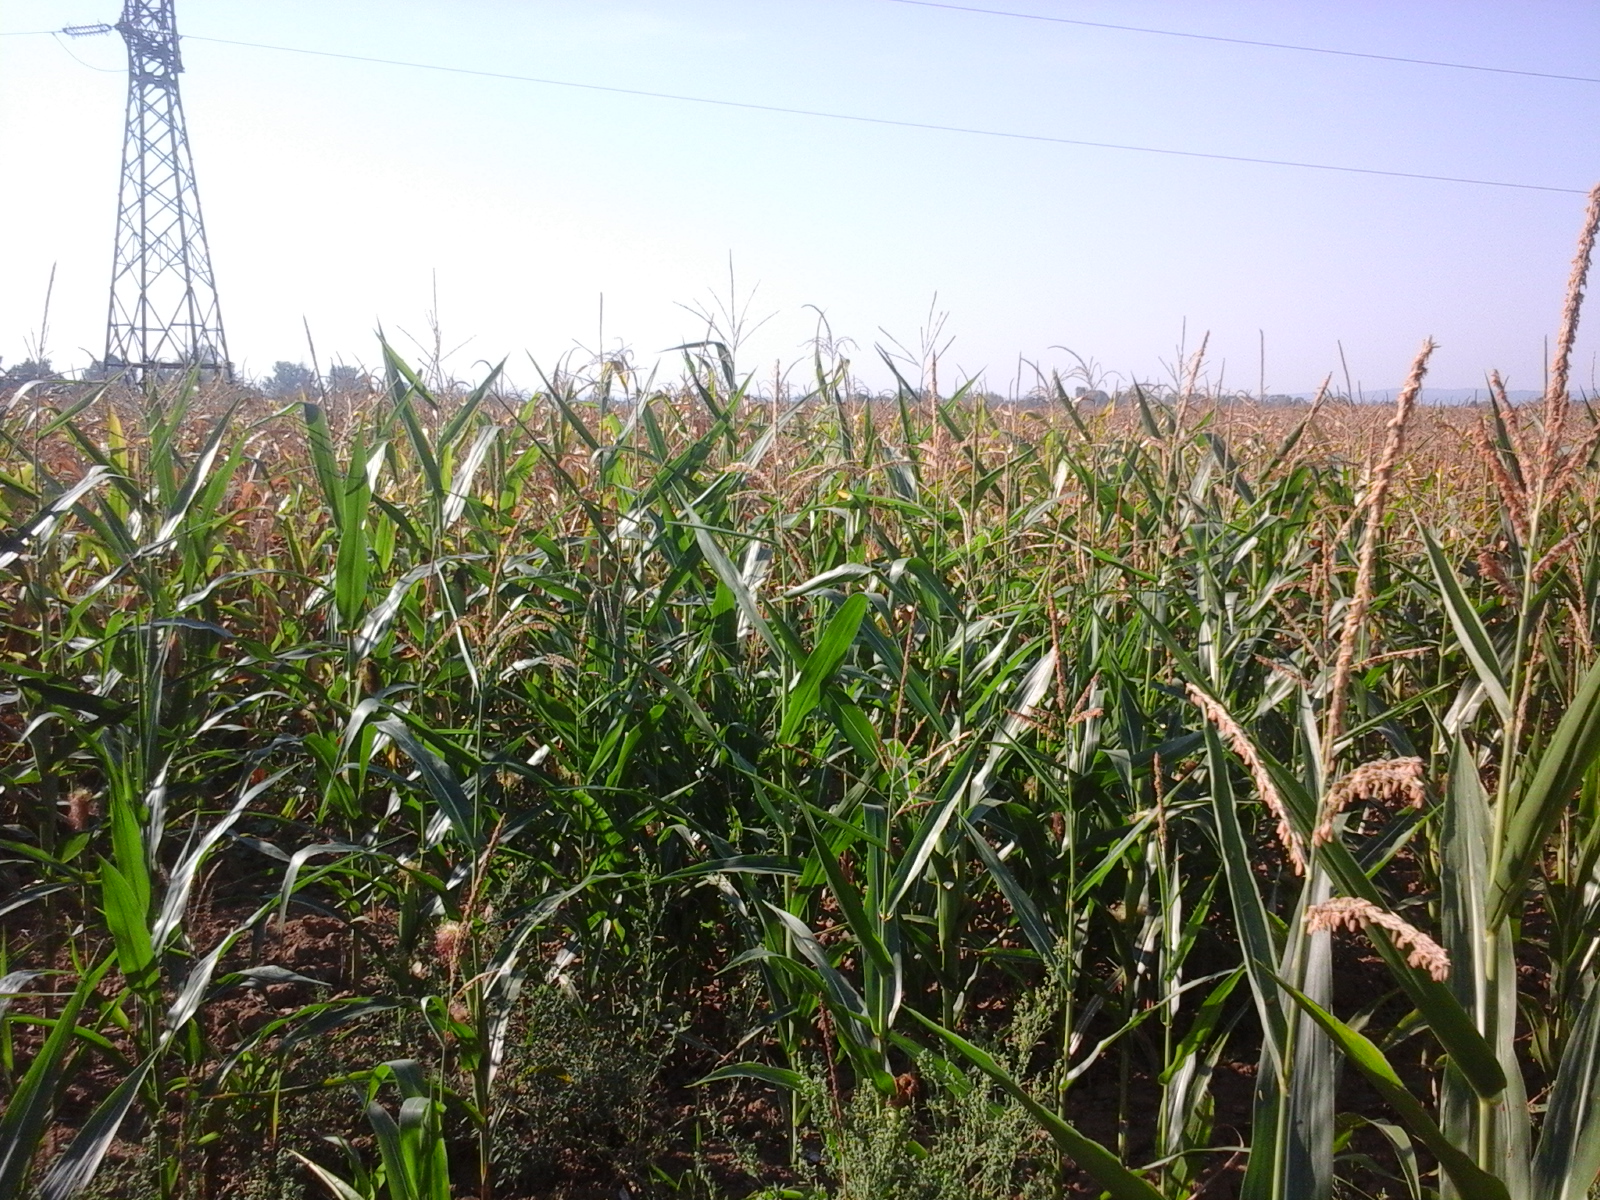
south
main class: Cropland
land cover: Maize
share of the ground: > 75 %
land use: Agriculture (excluding fallow land and kitchen gardens)
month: August
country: RO
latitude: 46.0202
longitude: 22.1470
